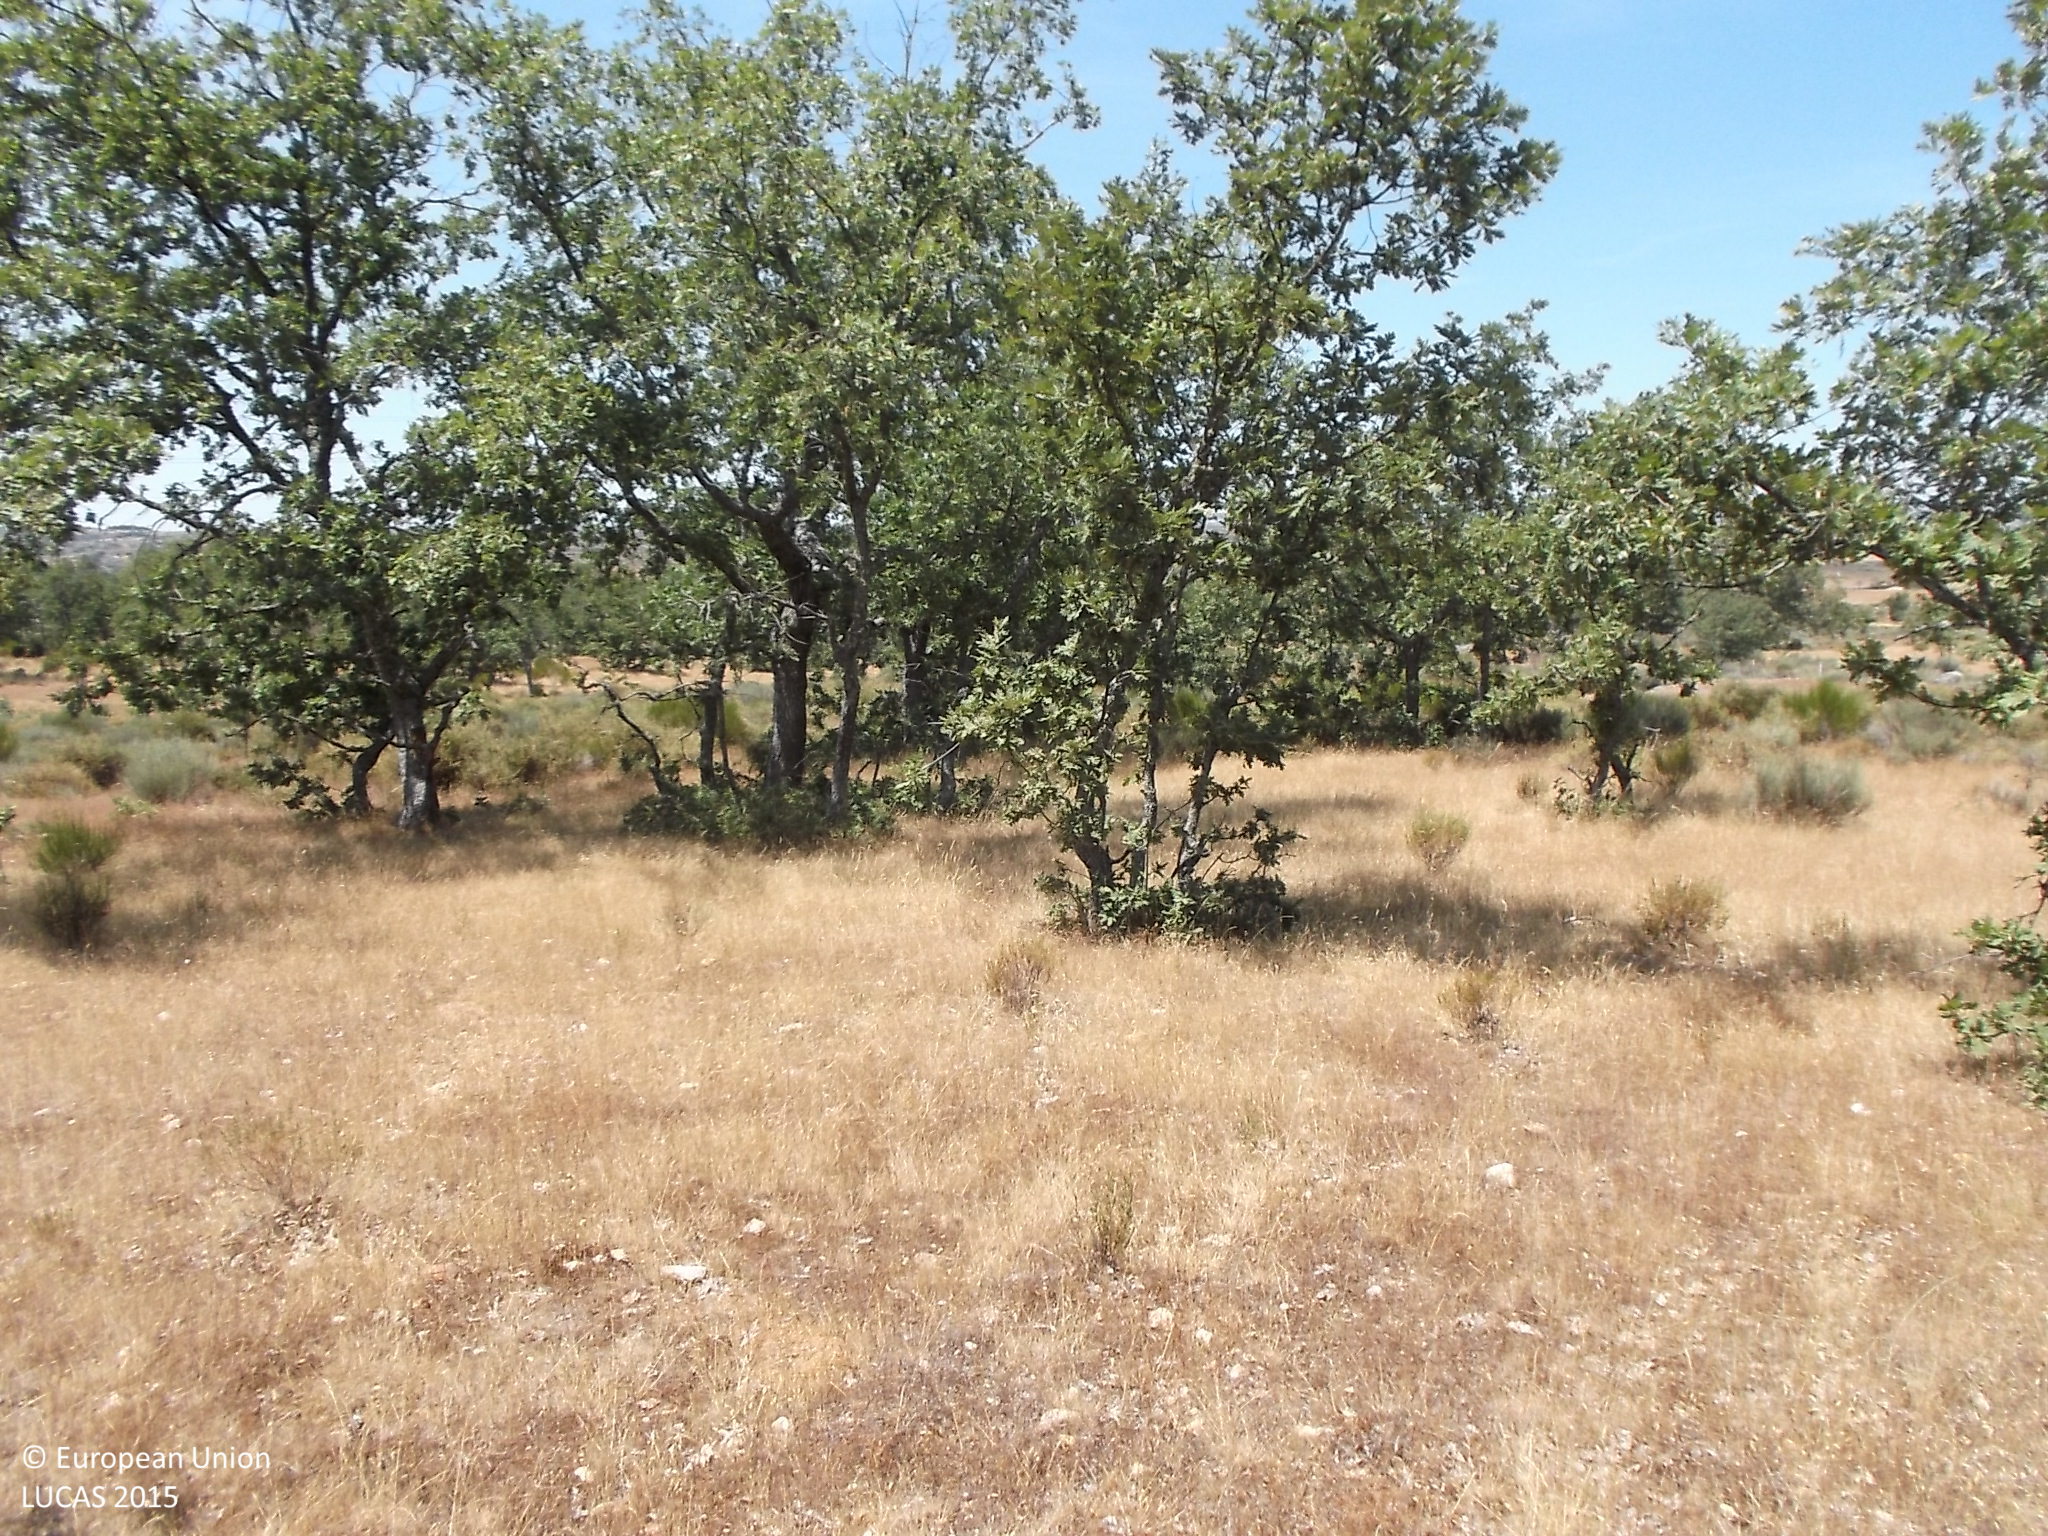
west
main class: Woodland
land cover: Broadleaved woodland
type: broadleaved evergreen forest
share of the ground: 25 - 50 %
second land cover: Shrubland without tree cover
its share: 25 - 50 %
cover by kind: broadleaved forest trees 40 %, shrubs 30 %, herbaceous plants 30 %
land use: Forestry
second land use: Agriculture (excluding fallow land and kitchen gardens)
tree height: < 5 m
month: July
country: ES
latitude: 41.2418
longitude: -6.4570
